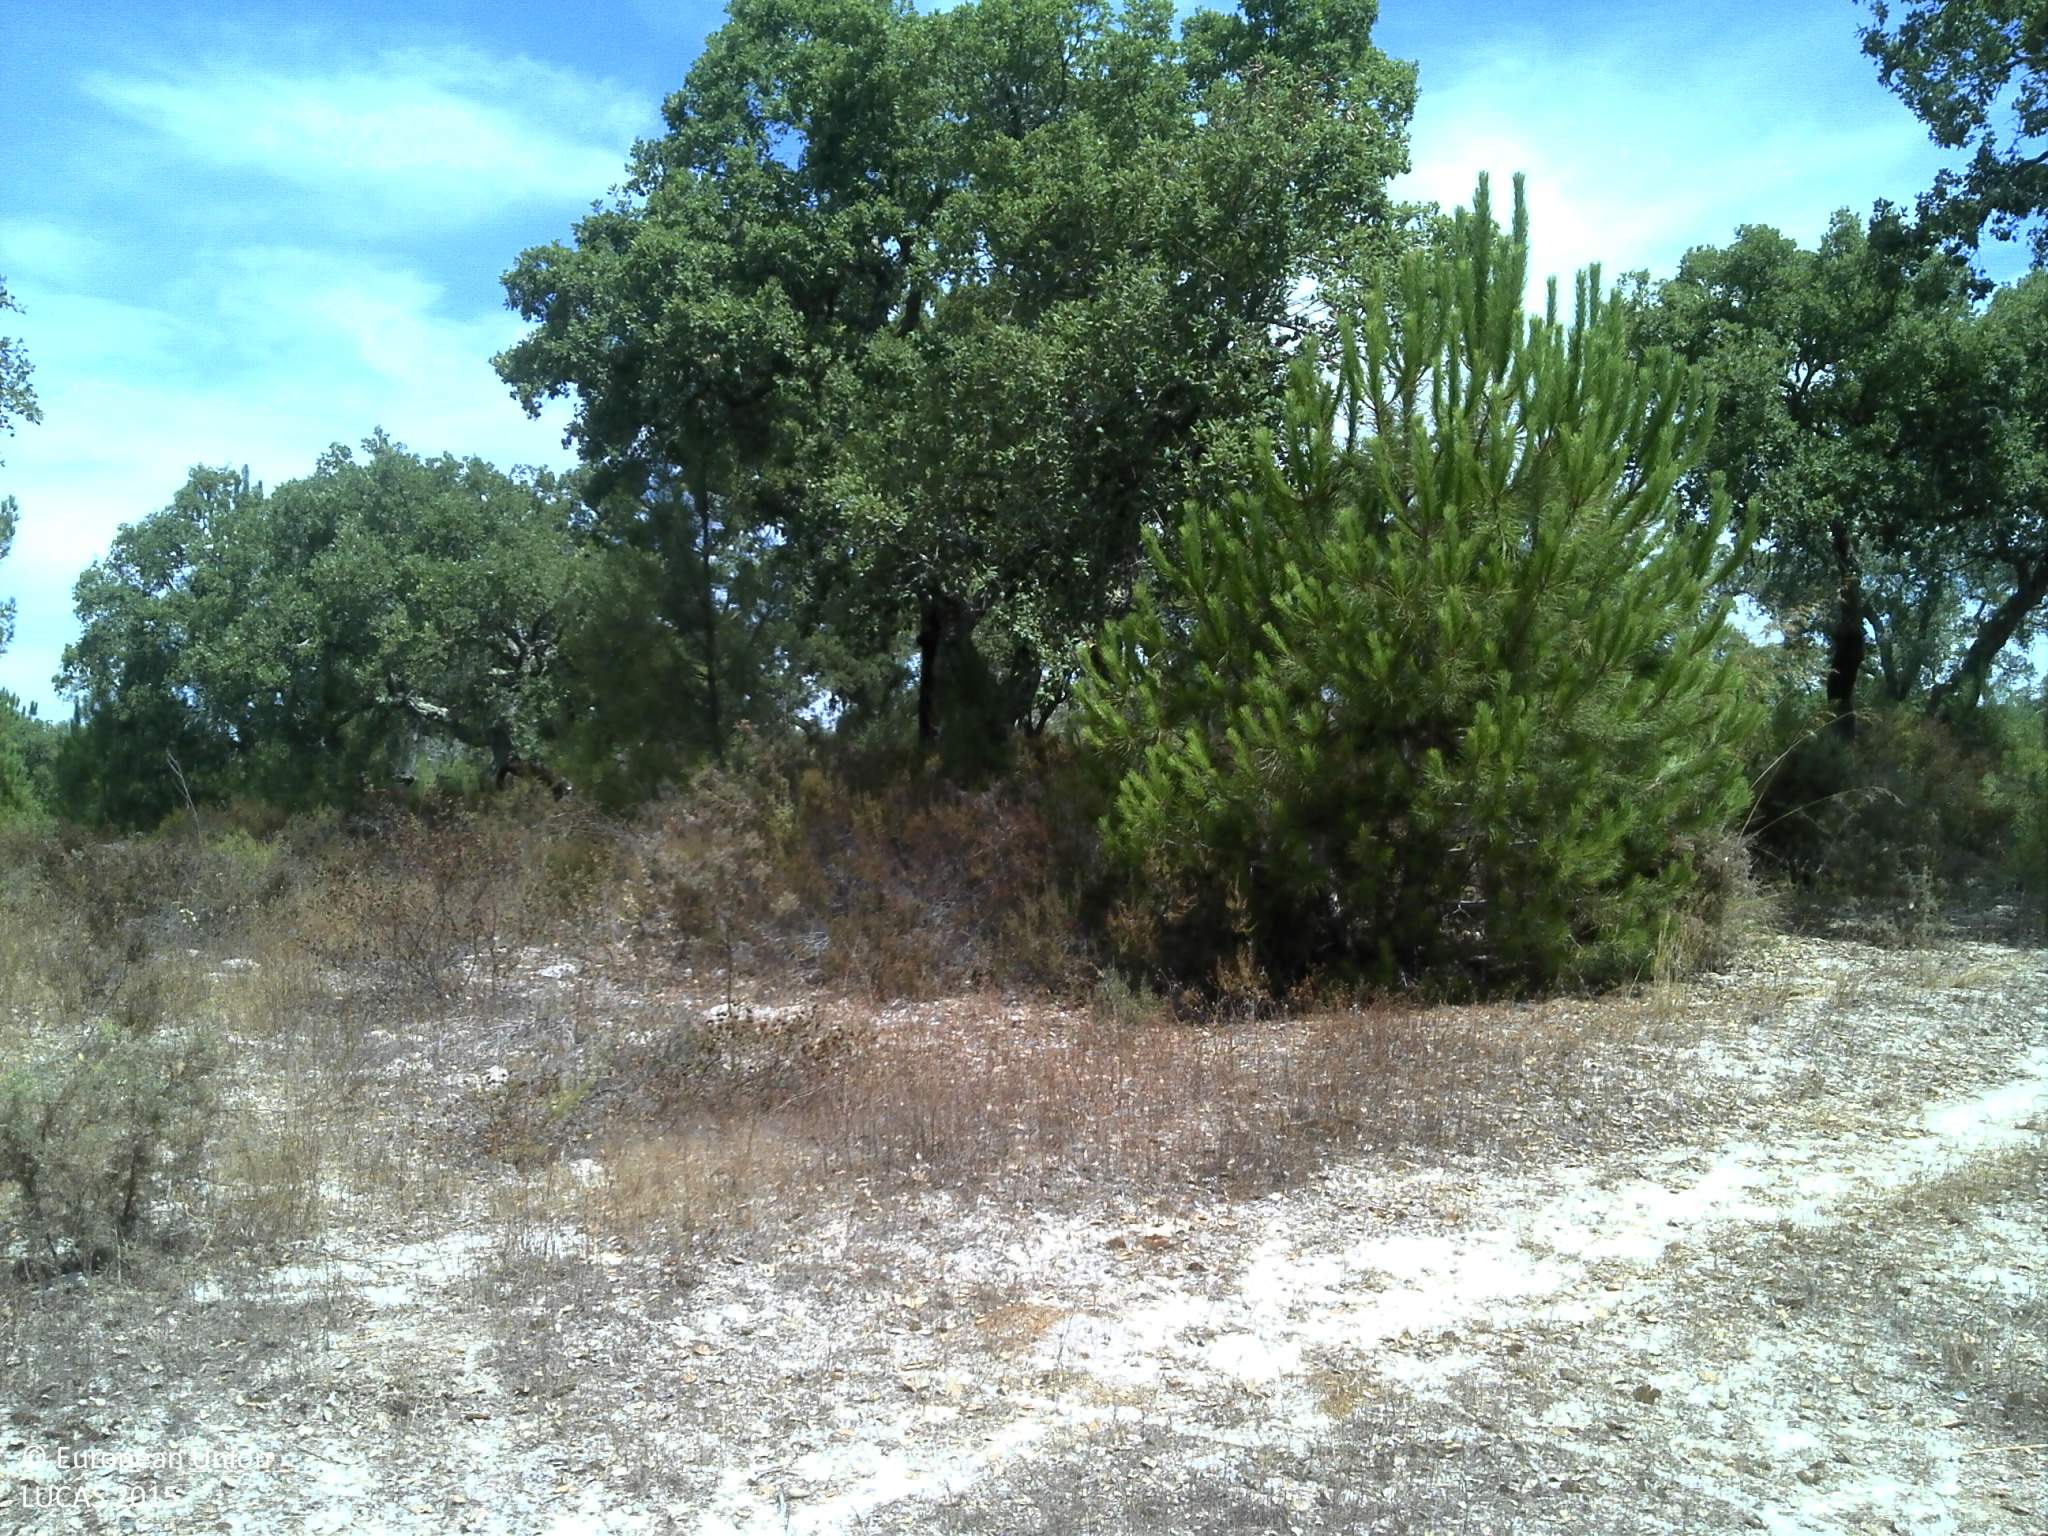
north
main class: Woodland
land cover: Broadleaved woodland
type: broadleaved evergreen forest
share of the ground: 25 - 50 %
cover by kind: broadleaved forest trees 45 %, herbaceous plants 40 %, unconsolidated bare surface 15 %
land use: Forestry
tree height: > 5 m
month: August
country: PT
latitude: 38.8324
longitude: -8.5499
